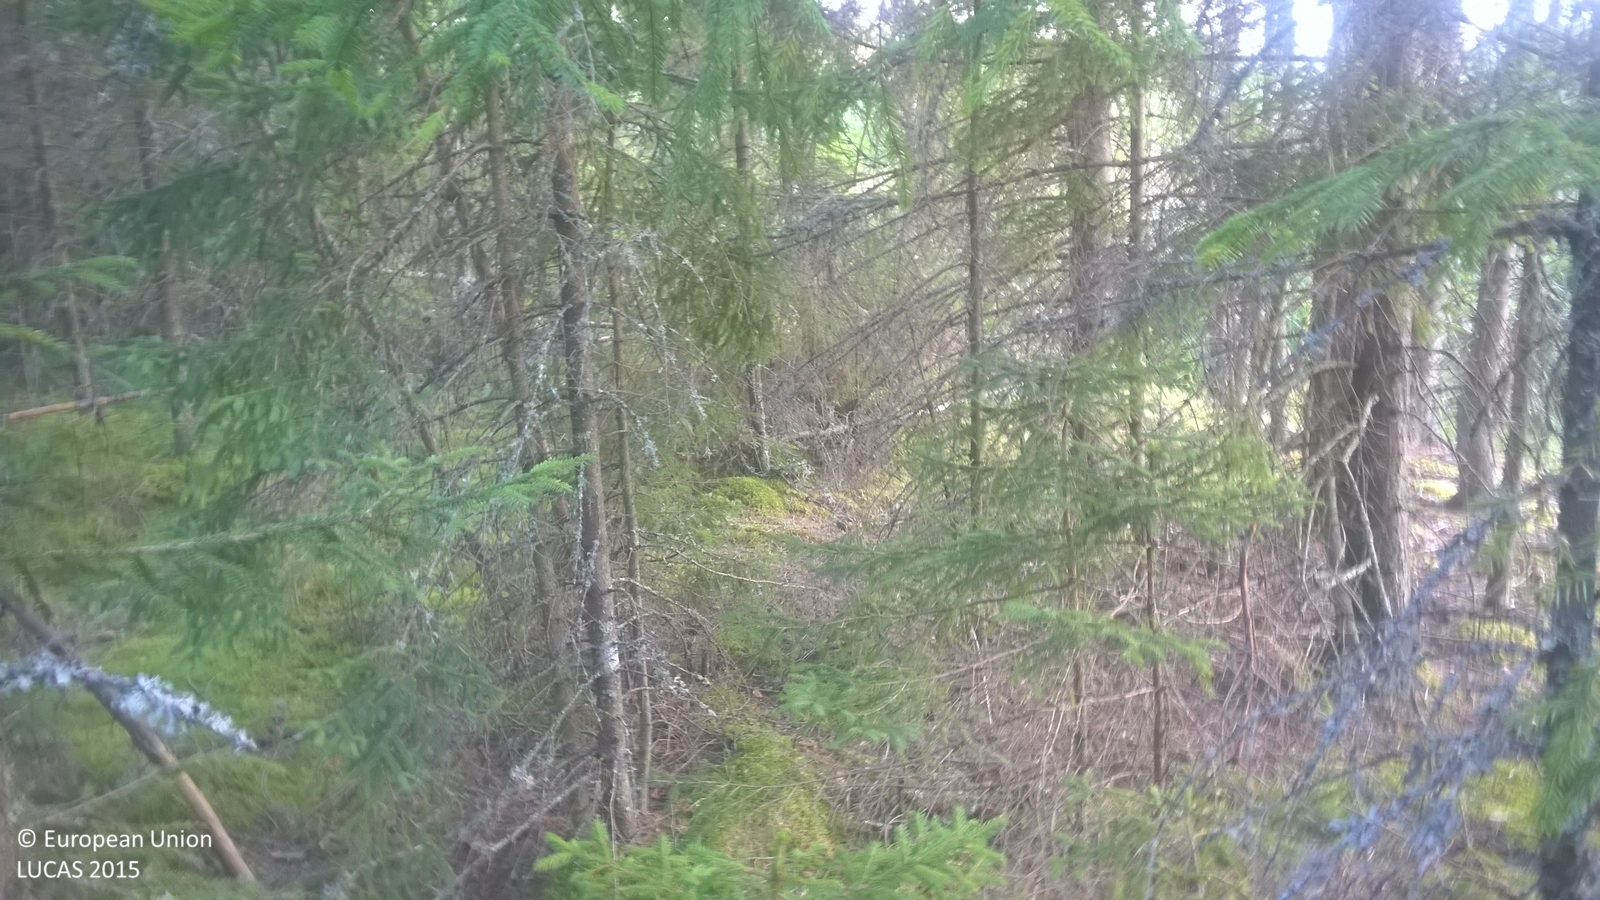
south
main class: Woodland
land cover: Spruce dominated coniferous woodland
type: hemiboreal forest and nemoral coniferous forest and mixed broadleaved-coniferous forest
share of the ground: > 75 %
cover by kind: coniferous forest trees 85 %, lichens and mosses 10 %, unconsolidated bare surface 5 %
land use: Forestry
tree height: > 5 m
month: August
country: LV
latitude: 57.6523
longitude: 26.0308
